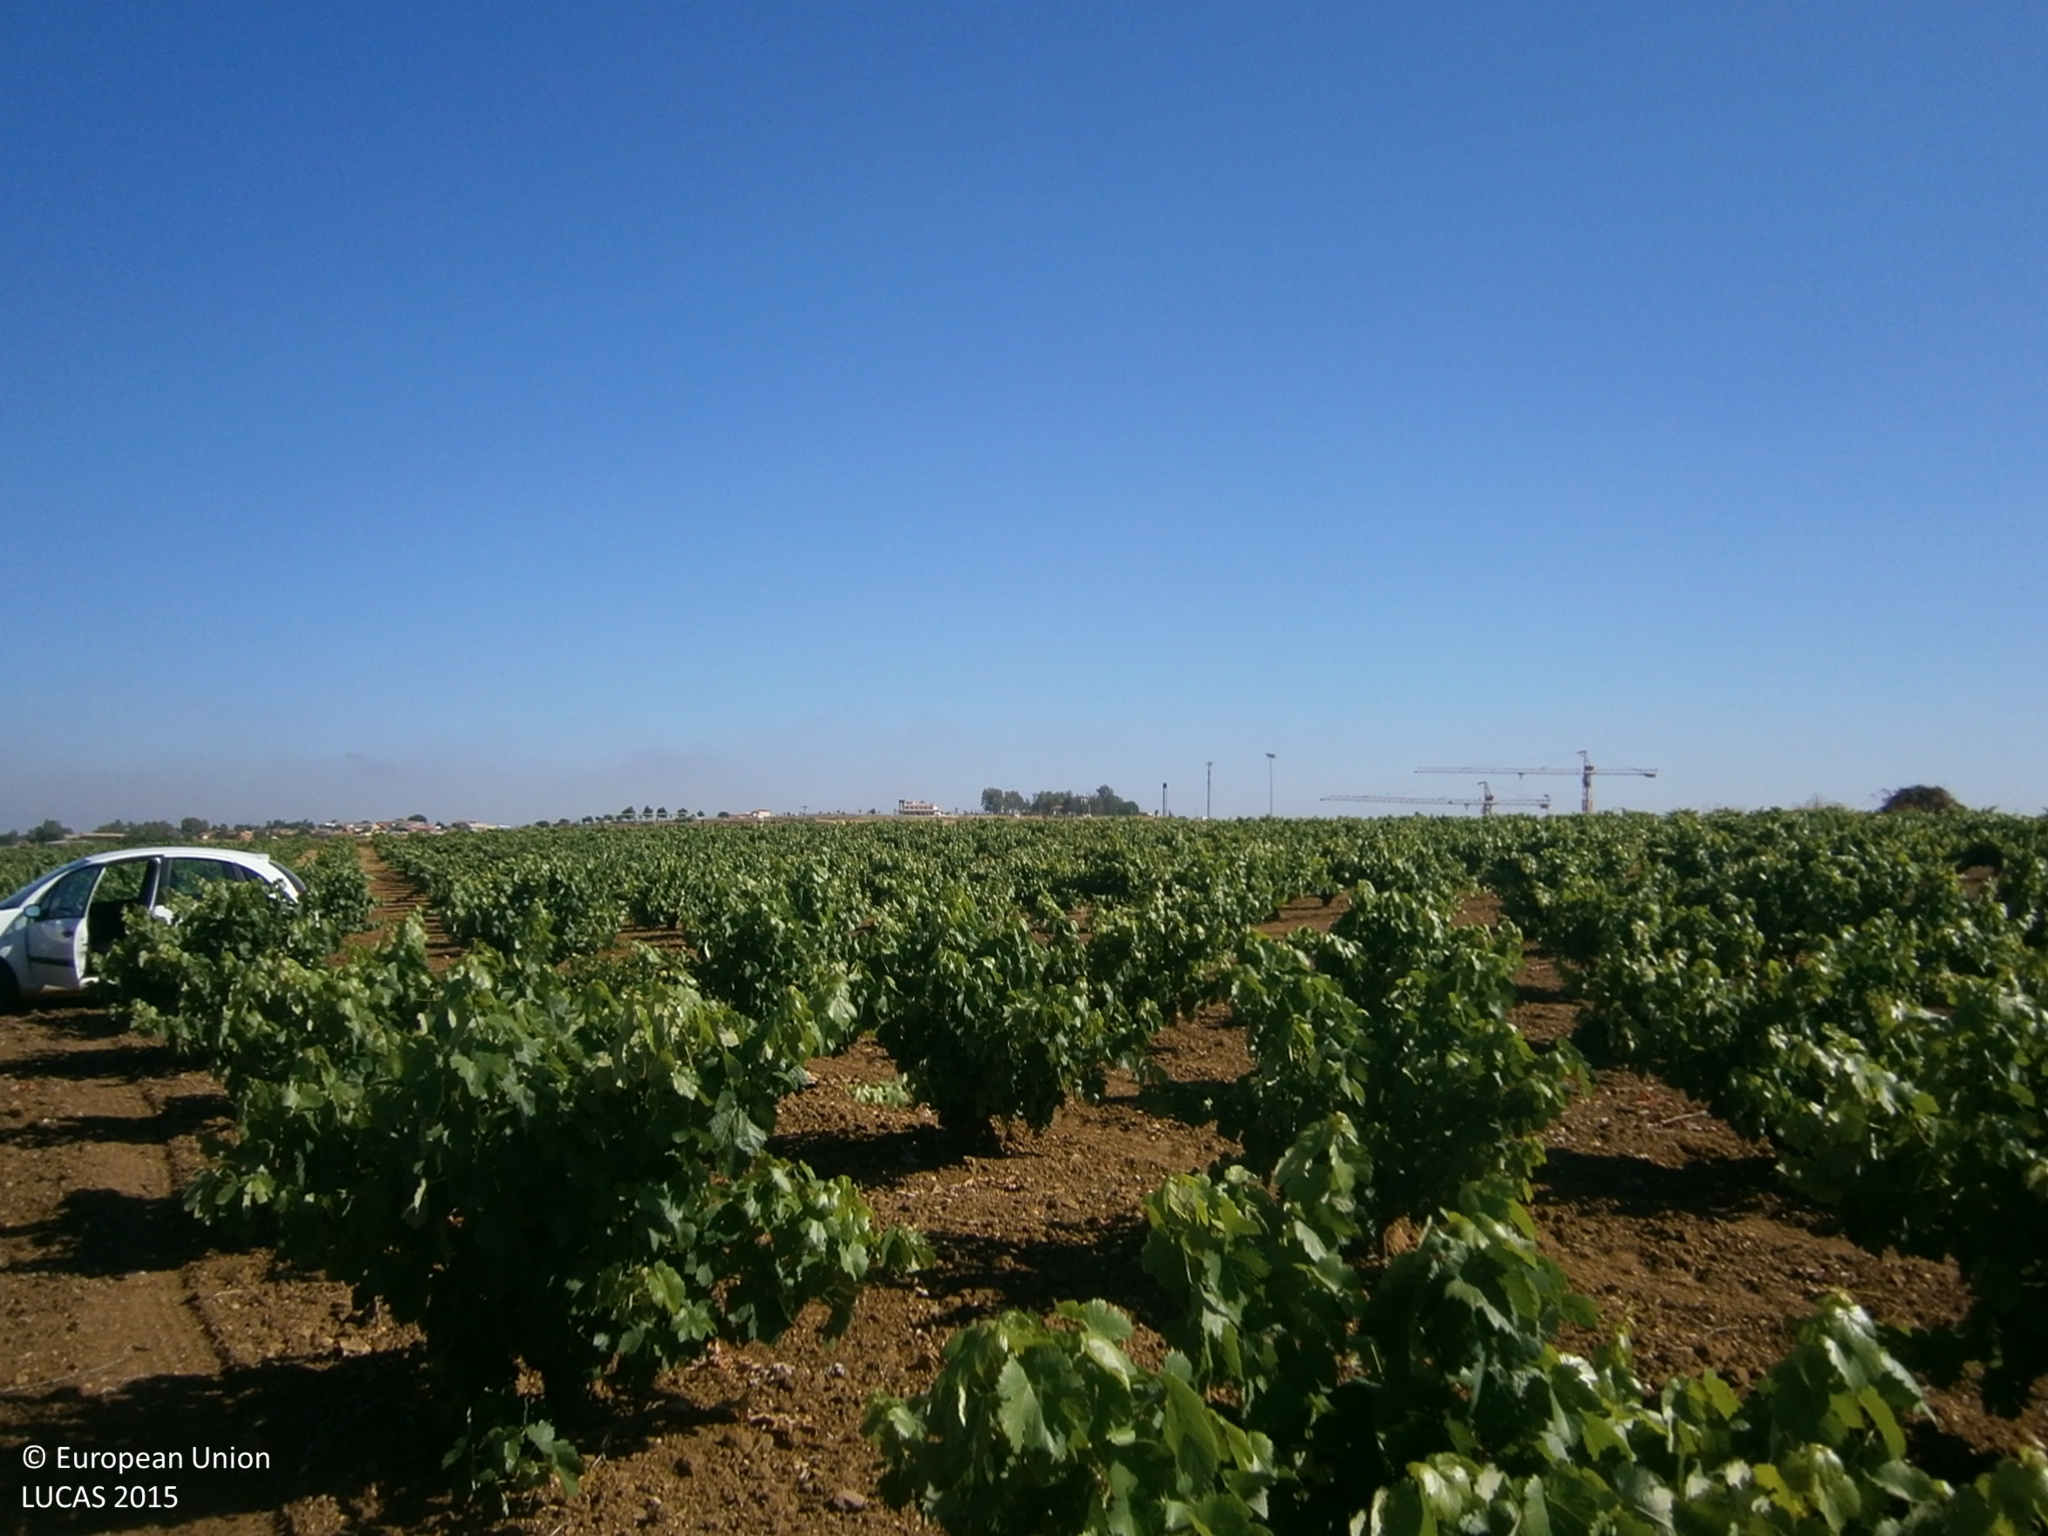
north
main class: Cropland
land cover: Vineyards
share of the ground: 25 - 50 %
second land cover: Other bare soil
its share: > 75 %
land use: Agriculture (excluding fallow land and kitchen gardens)
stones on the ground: < 10 %
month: June
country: ES
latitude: 38.6860
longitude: -6.4373
